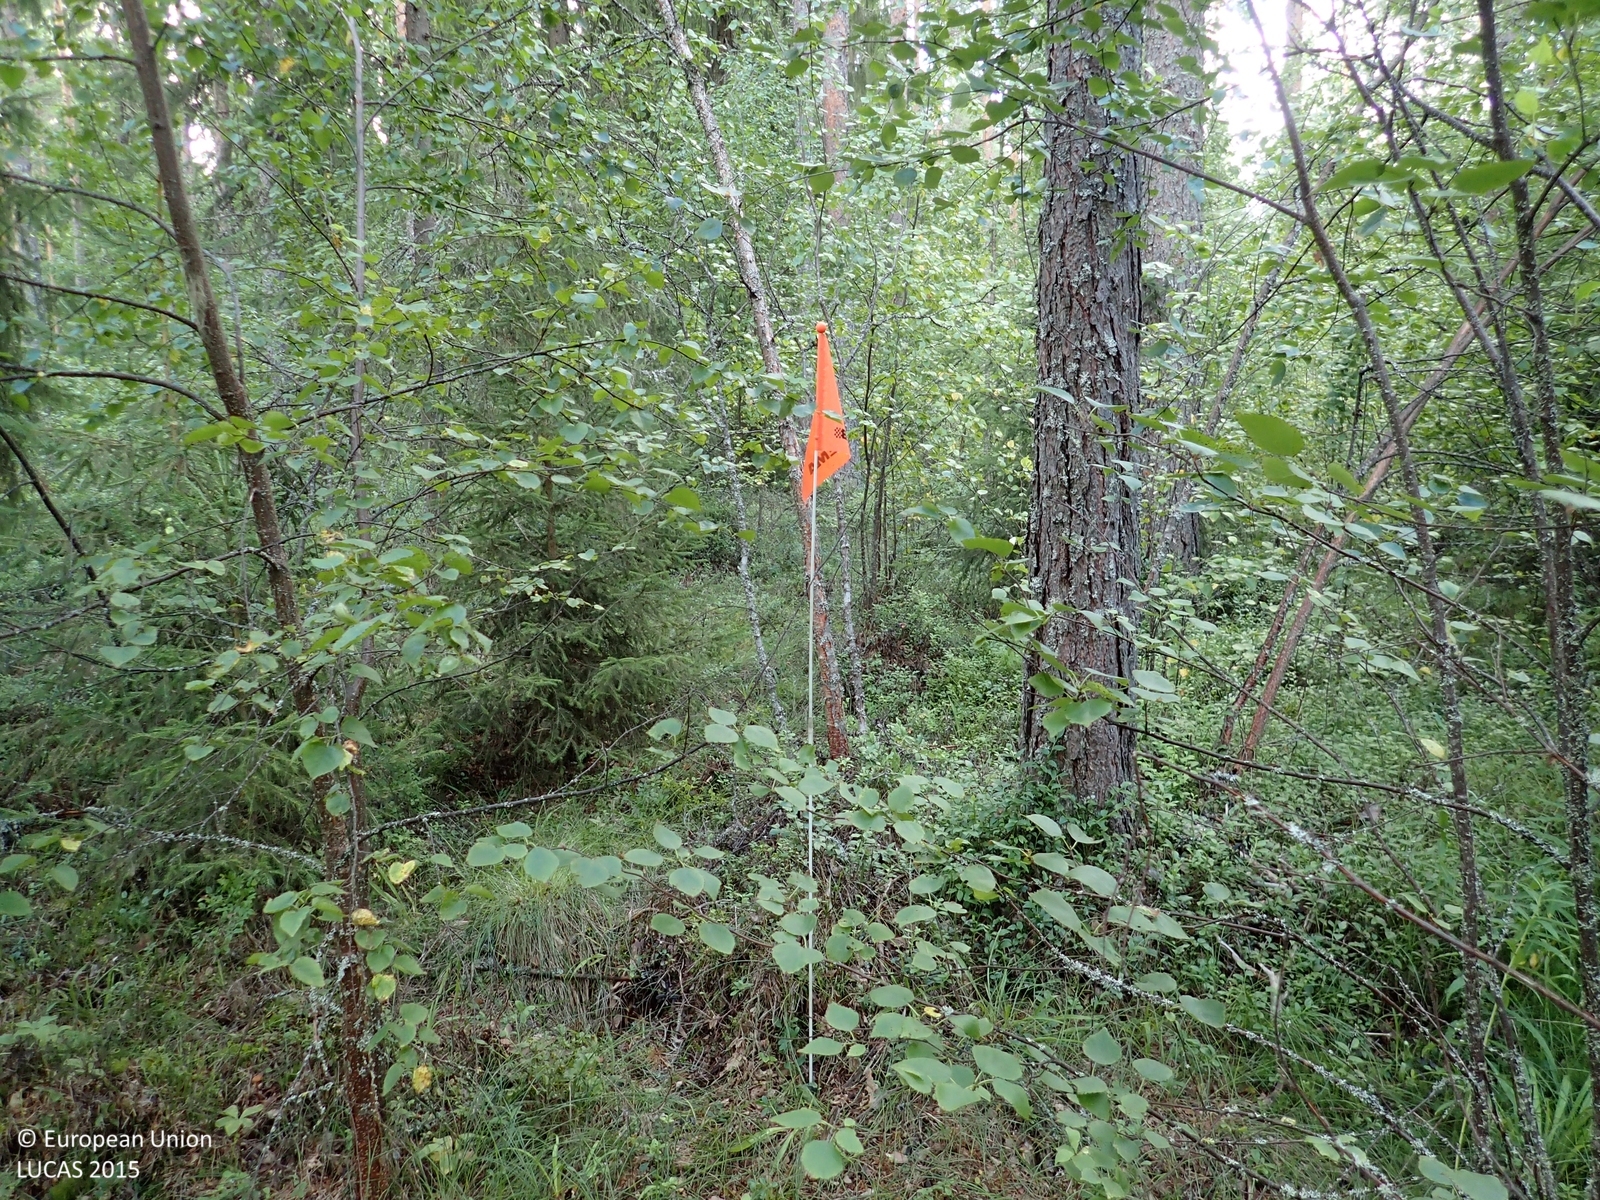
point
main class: Woodland
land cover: Pine dominated mixed woodland
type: boreal forest
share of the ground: > 75 %
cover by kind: coniferous forest trees 60 %, broadleaved forest trees 20 %, shrubs 15 %, herbaceous plants 5 %
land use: Forestry
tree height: > 5 m
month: August
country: FI
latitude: 62.7513
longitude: 22.0091
